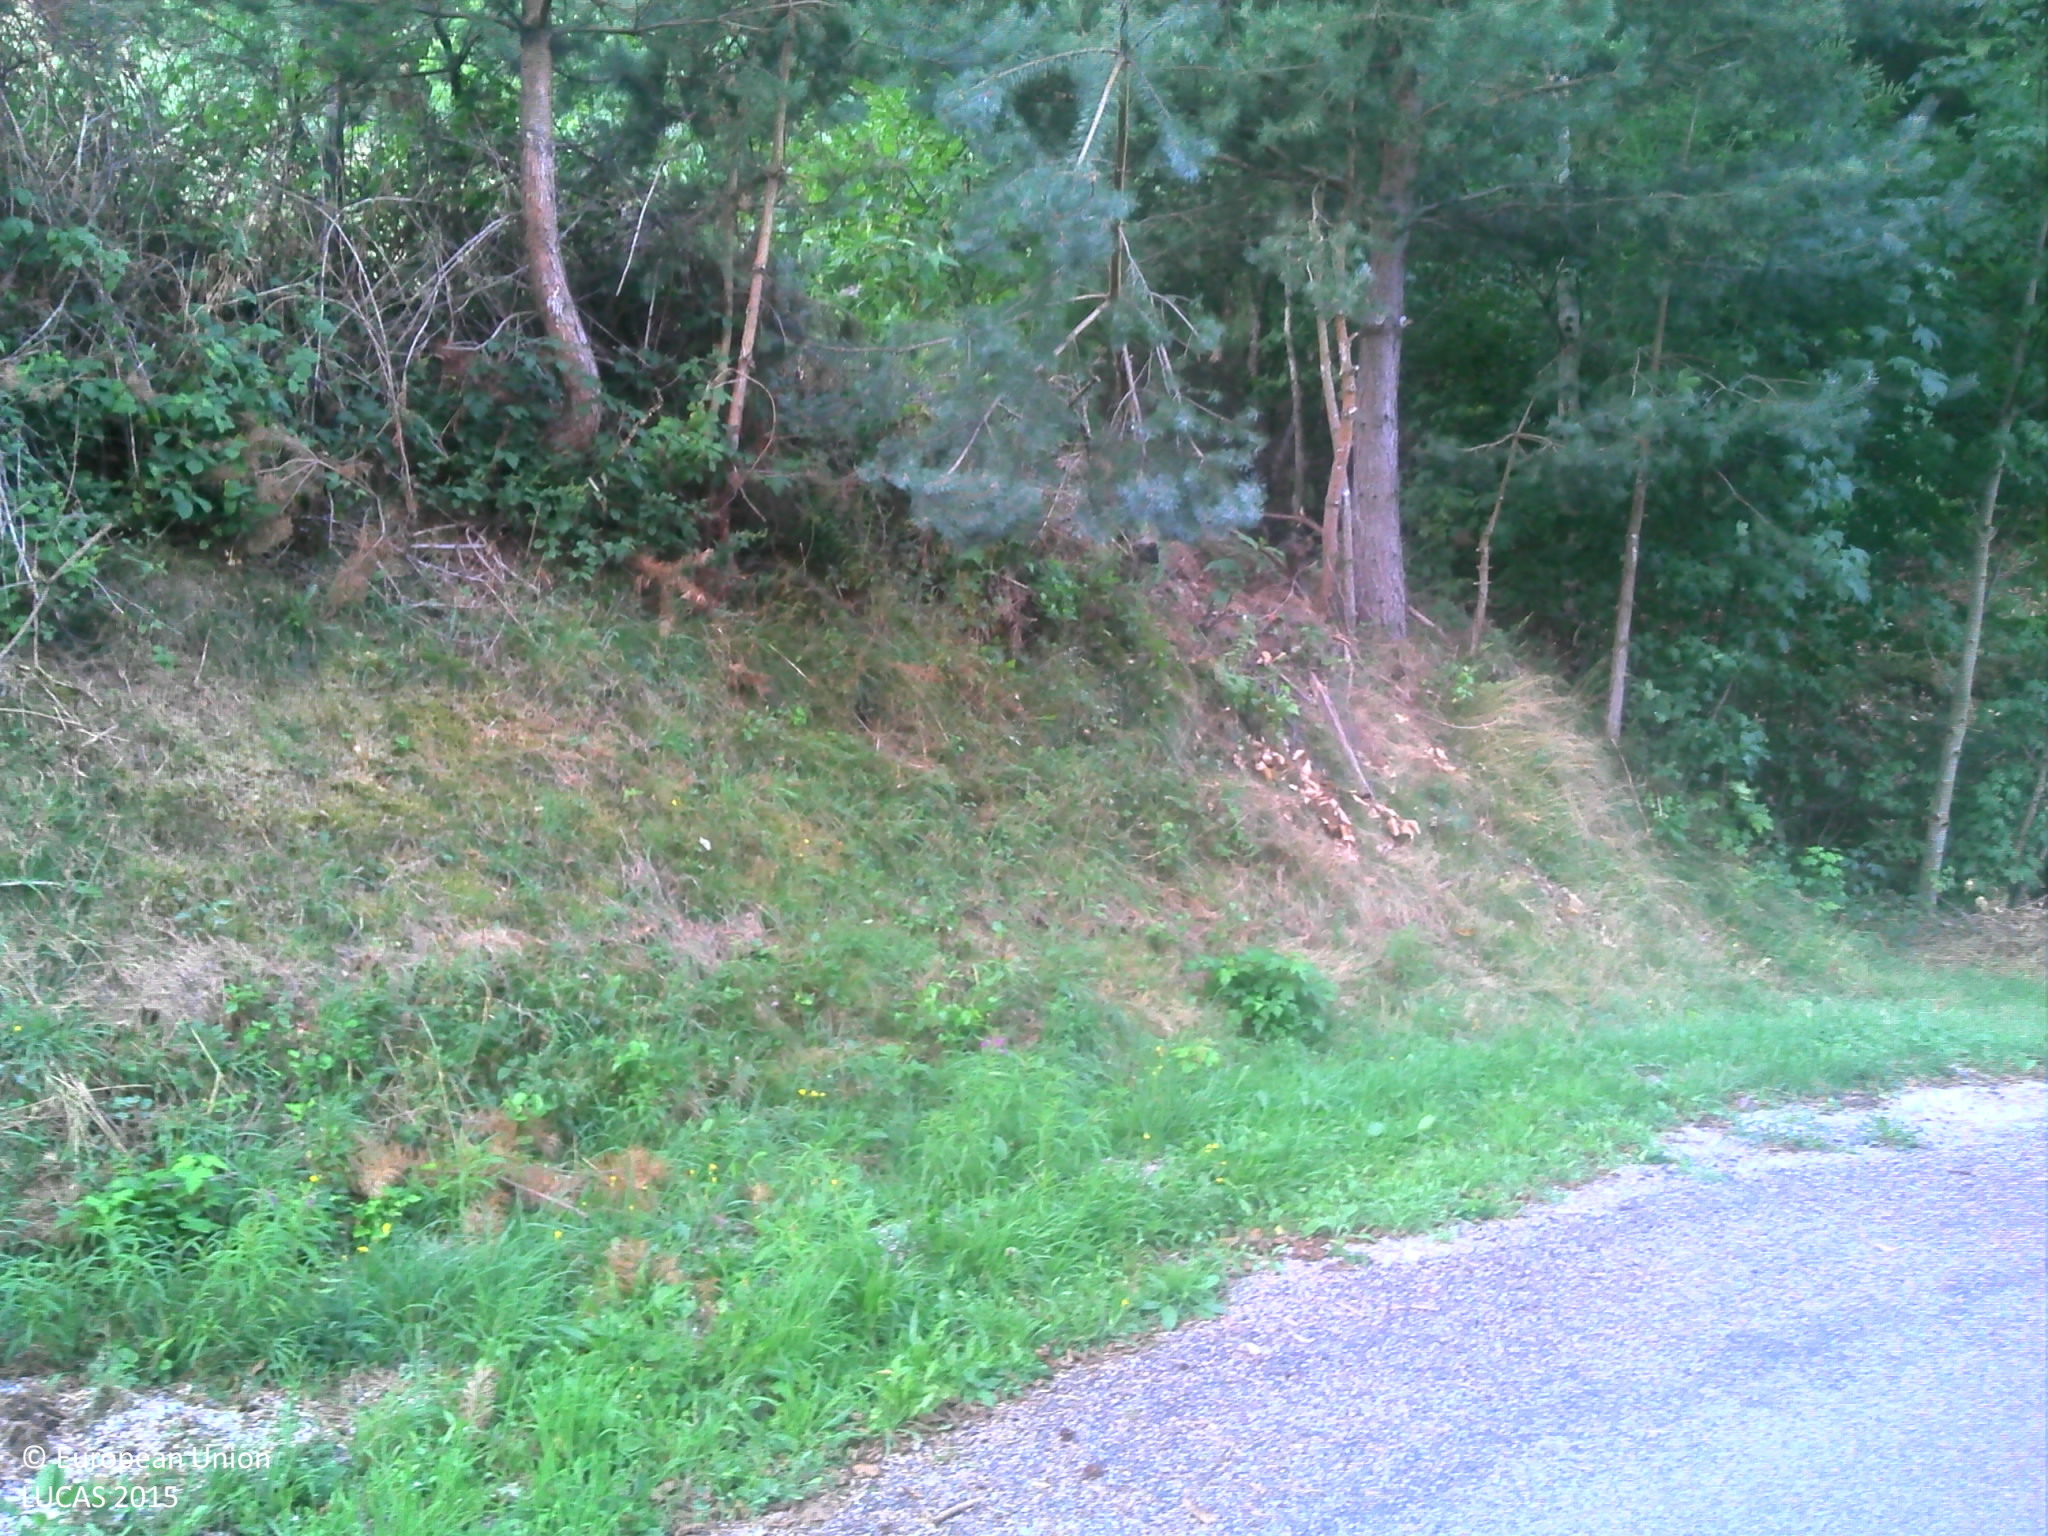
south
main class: Woodland
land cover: Broadleaved woodland
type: floodplain forest
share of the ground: > 75 %
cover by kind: broadleaved forest trees 80 %, shrubs 20 %
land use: Semi-natural and natural areas not in use
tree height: > 5 m
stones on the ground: < 10 %
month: September
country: FR
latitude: 45.1482
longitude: 4.5740
